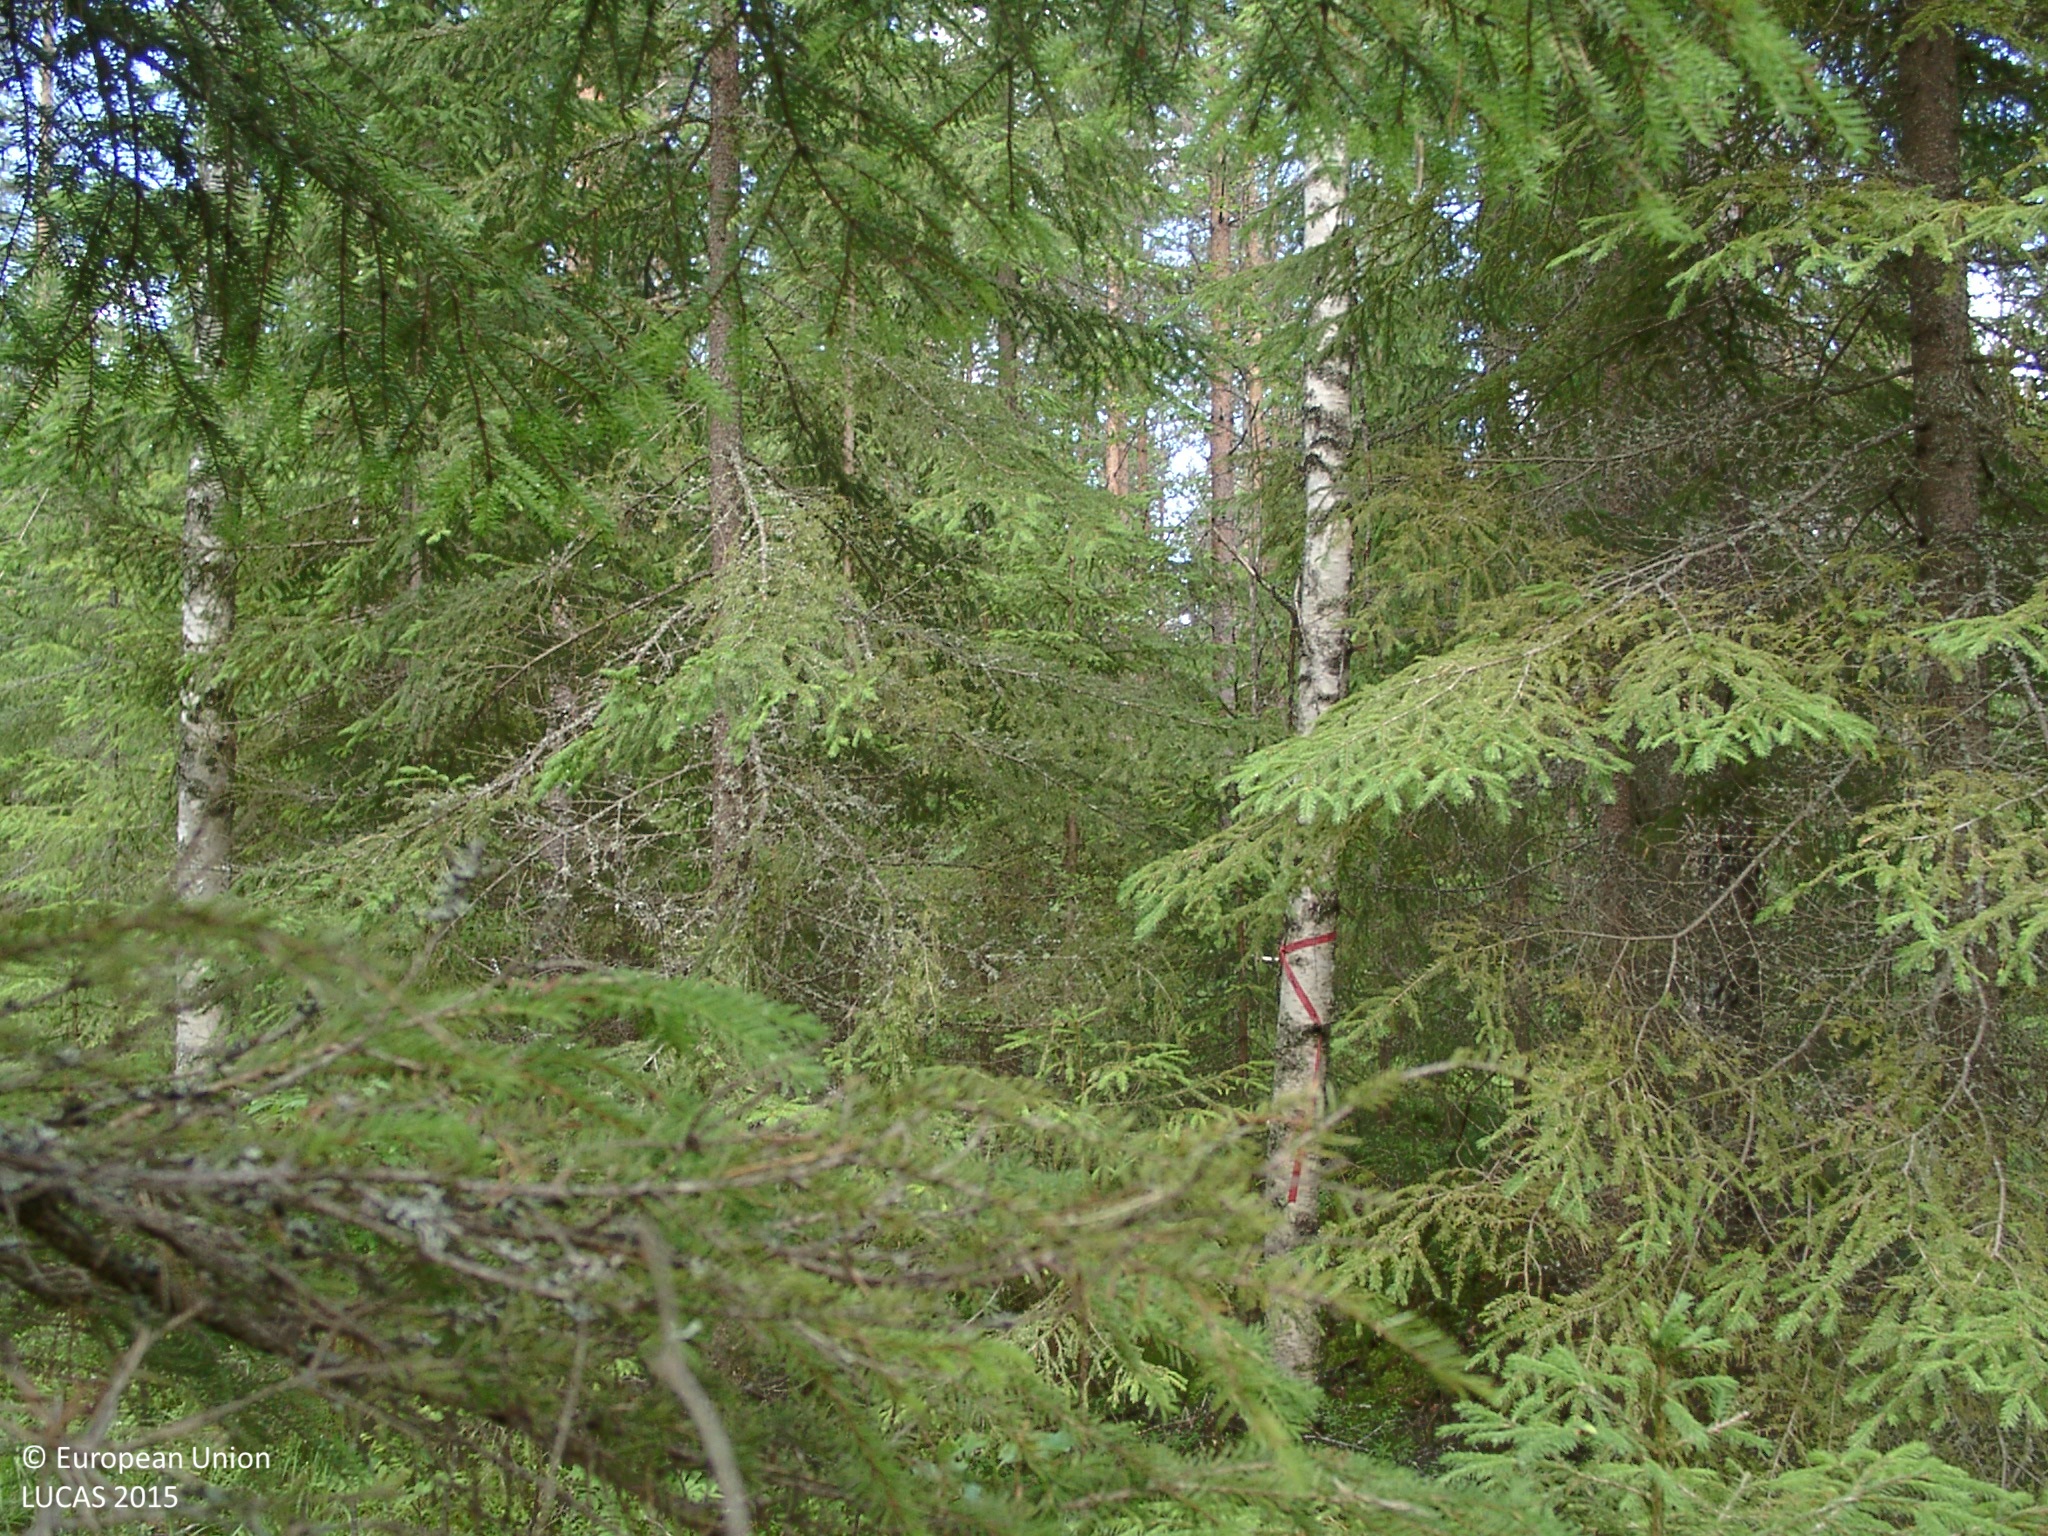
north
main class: Woodland
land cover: Other coniferous woodland
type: boreal forest
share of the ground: 50 - 75 %
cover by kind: coniferous forest trees 55 %, shrubs 20 %, herbaceous plants 10 %, lichens and mosses 10 %, broadleaved forest trees 5 %
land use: Forestry
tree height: > 5 m
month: July
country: FI
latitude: 62.1832
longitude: 25.0295
